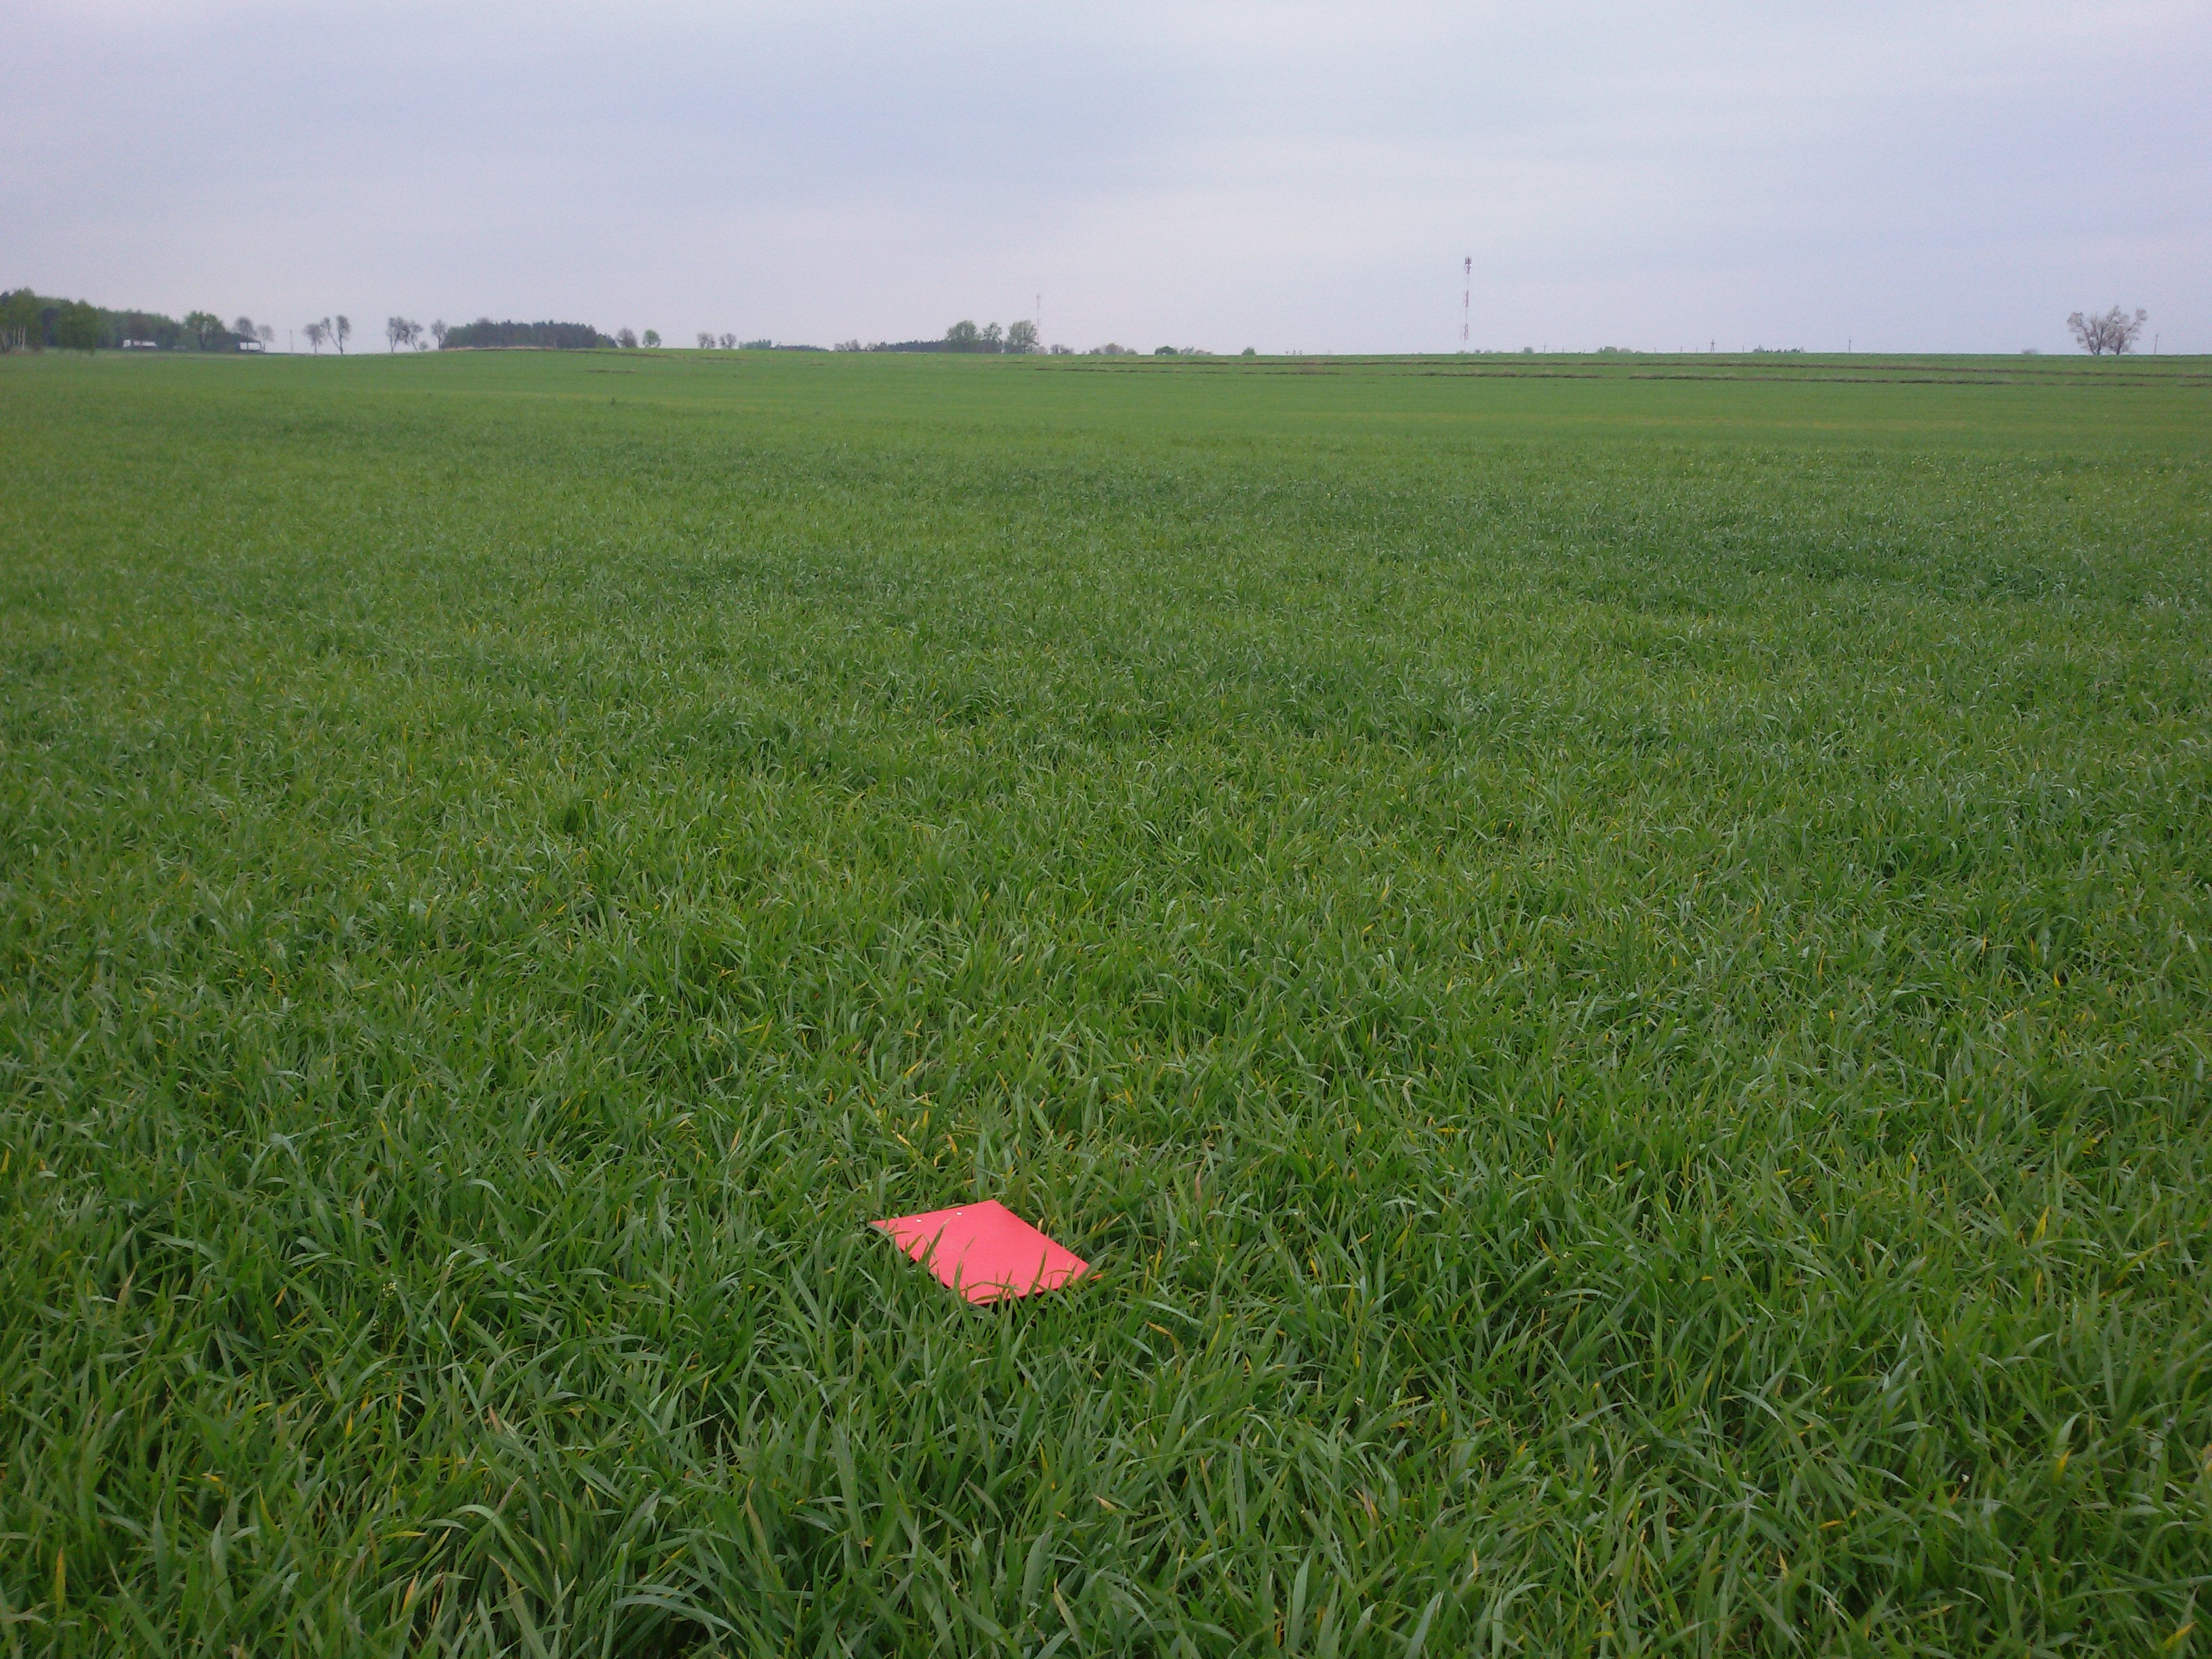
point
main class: Cropland
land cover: Barley
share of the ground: > 75 %
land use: Agriculture (excluding fallow land and kitchen gardens)
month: May
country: PL
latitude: 52.8558
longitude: 22.0134
